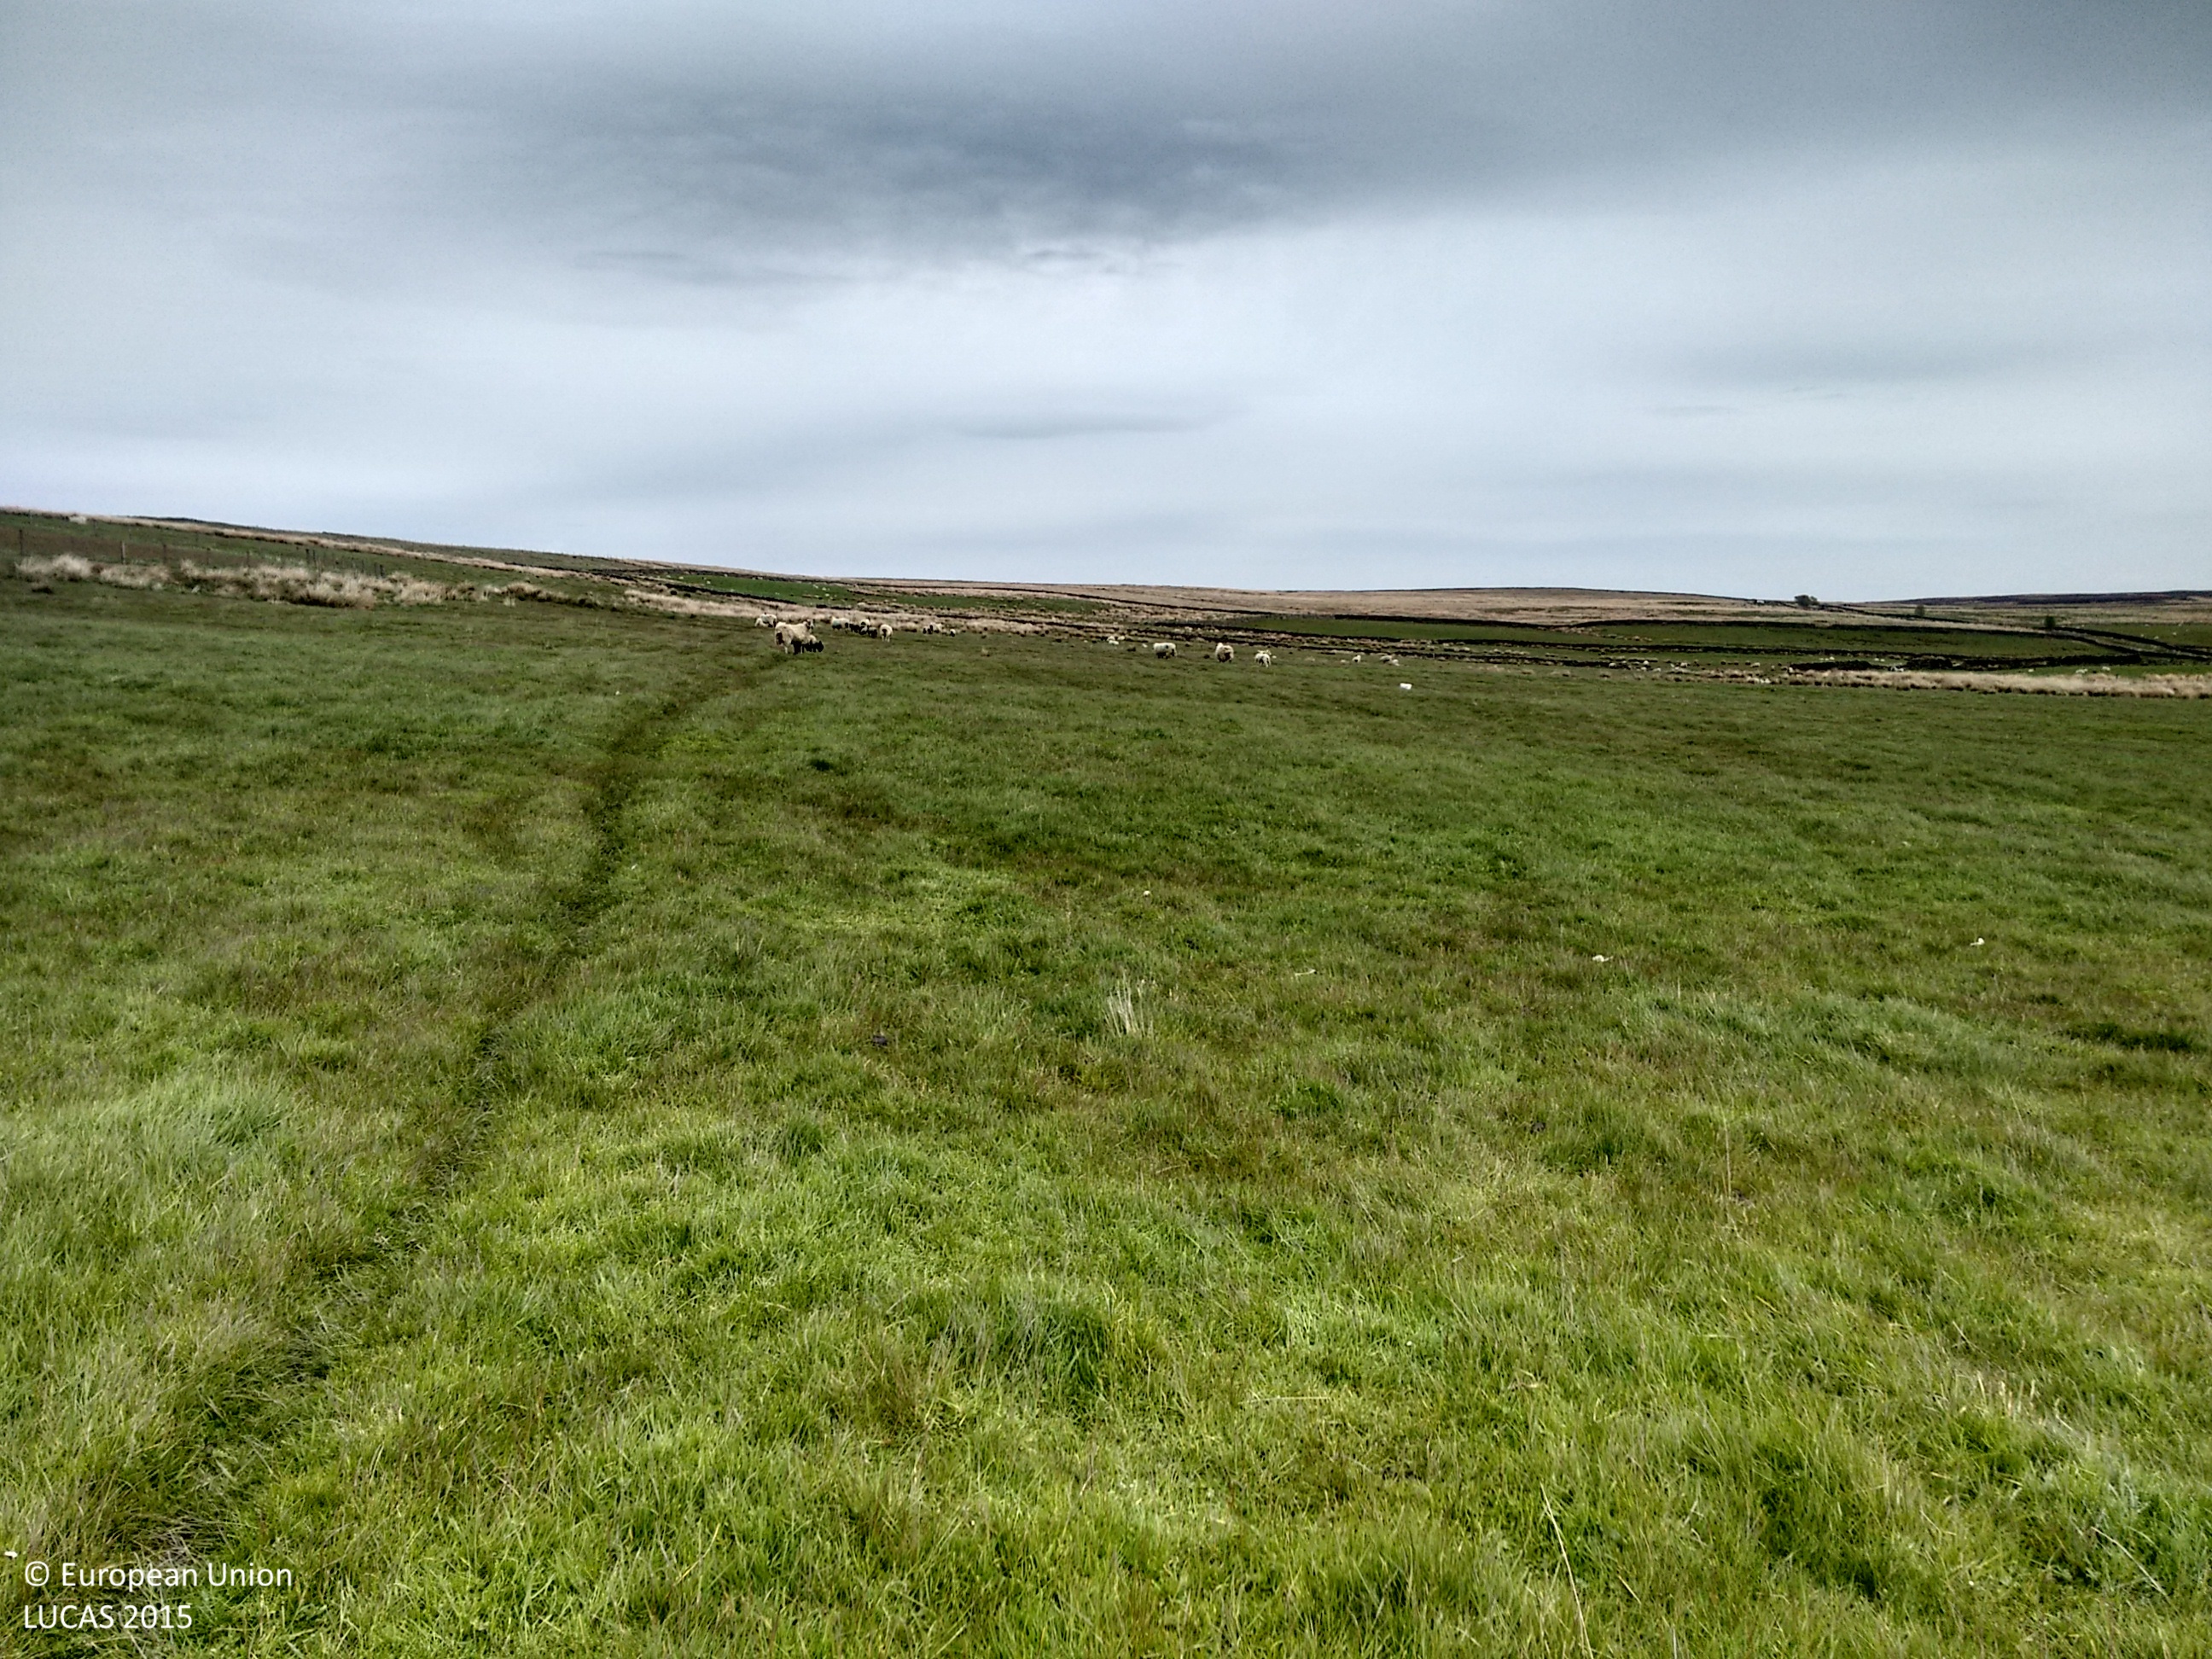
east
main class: Grassland
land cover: Grassland without tree/shrub cover
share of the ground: > 75 %
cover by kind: herbaceous plants 100 %
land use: Agriculture (excluding fallow land and kitchen gardens)
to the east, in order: Grassland without tree/shrub cover; Dry stone walls; Grassland without tree/shrub cover
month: May
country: GB
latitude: 54.9073
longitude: -2.2398
